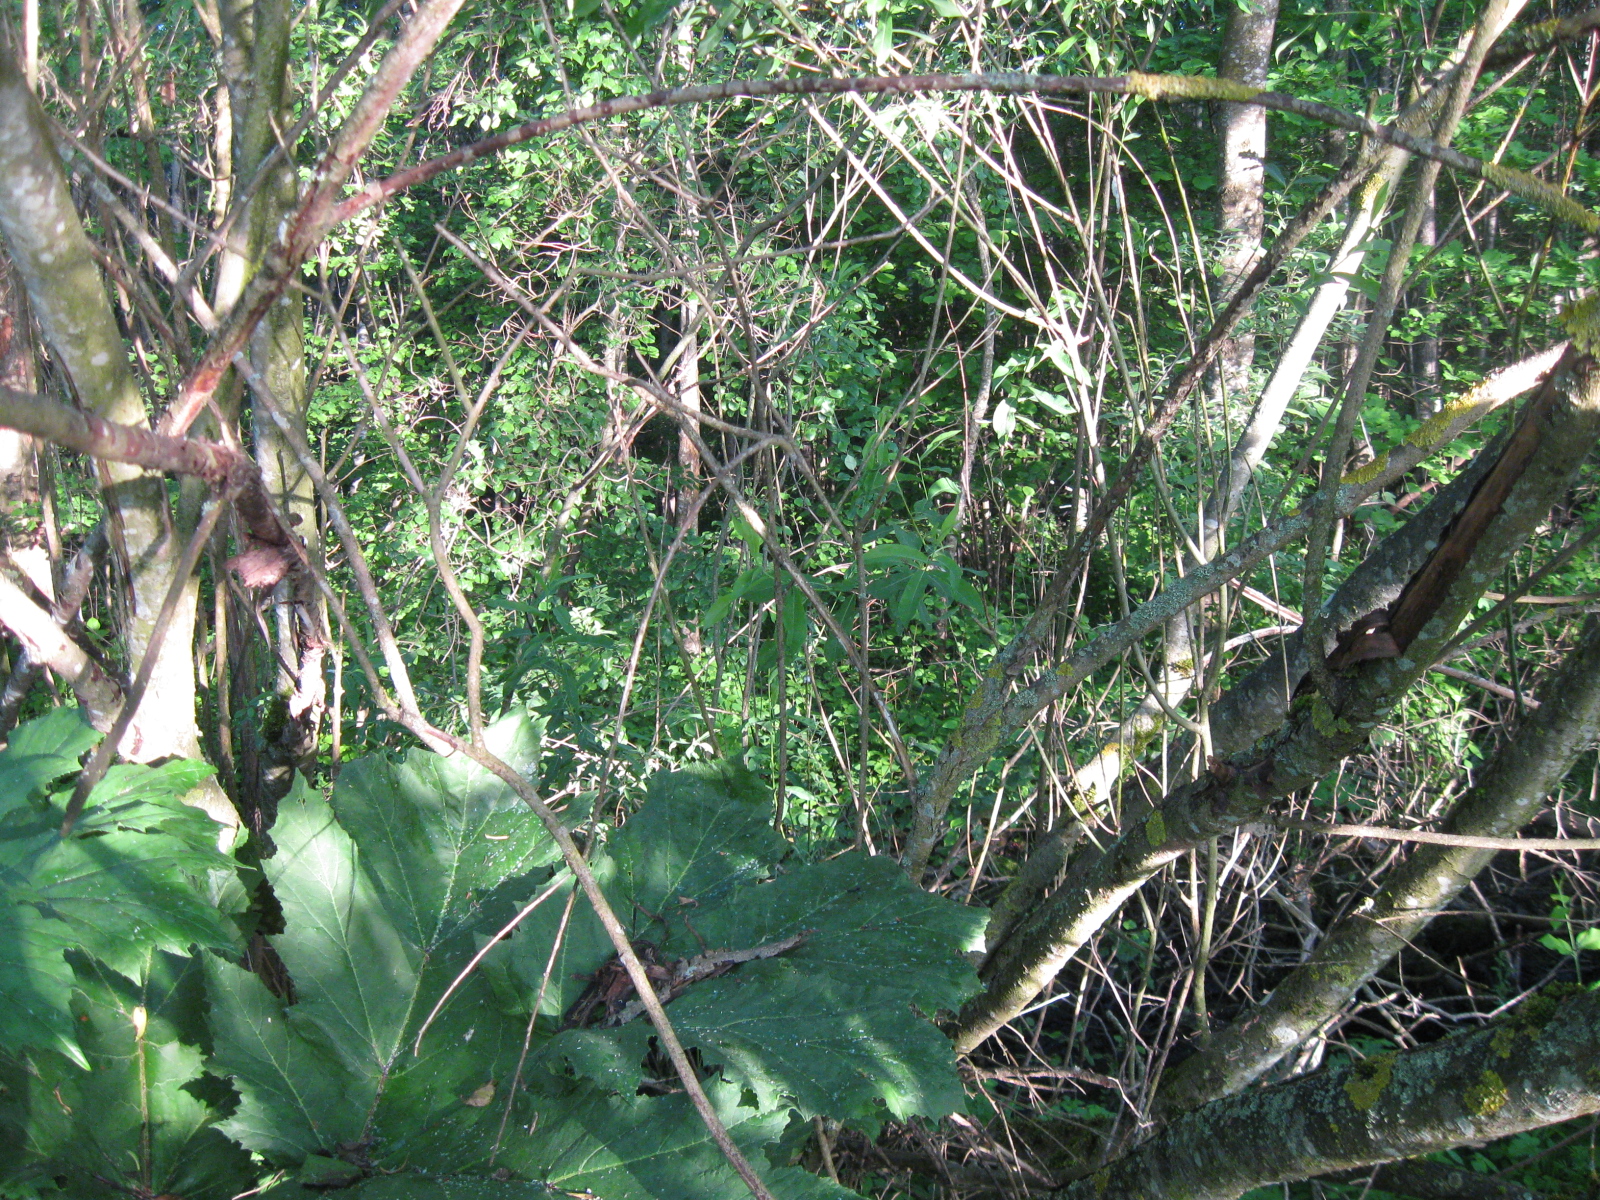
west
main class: Woodland
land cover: Broadleaved woodland
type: non-riverine alder, birch or aspen forest
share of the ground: > 75 %
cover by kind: broadleaved forest trees 90 %, herbaceous plants 10 %
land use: Forestry
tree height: > 5 m
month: June
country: LT
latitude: 55.0664
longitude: 24.0116
